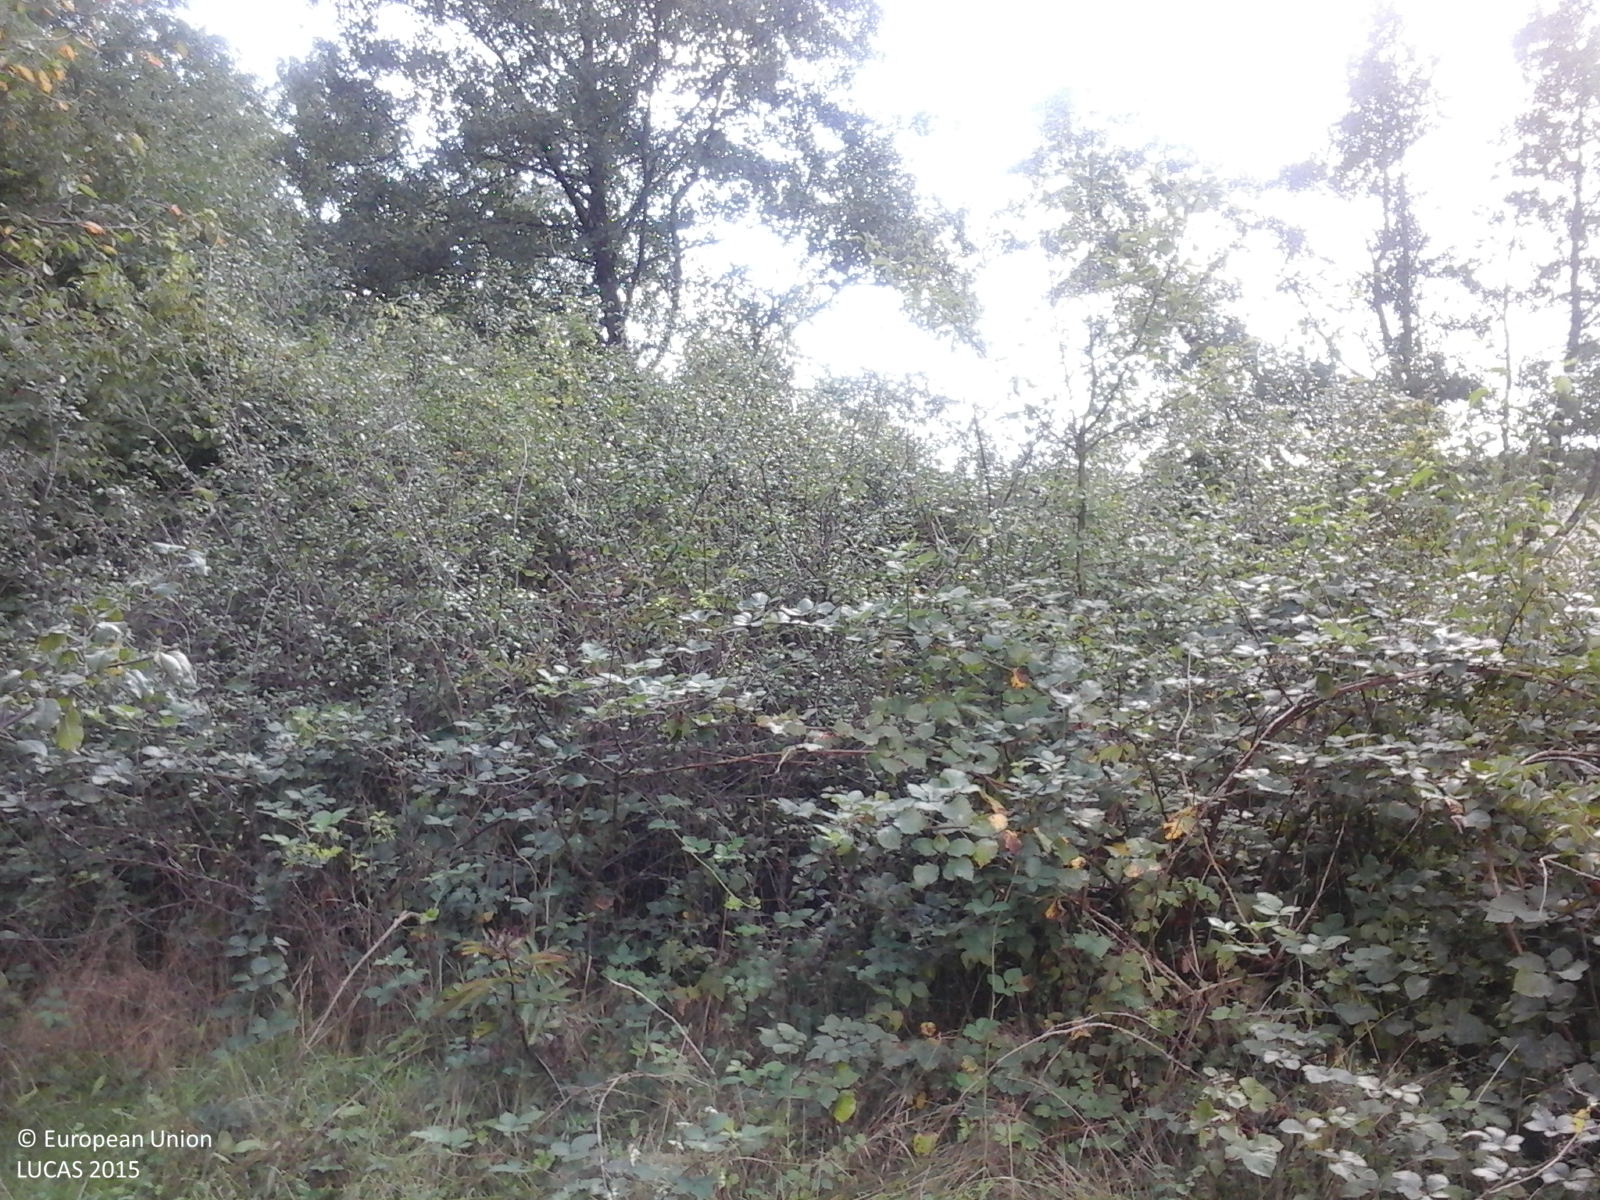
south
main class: Woodland
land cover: Broadleaved woodland
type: beech forest
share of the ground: > 75 %
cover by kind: broadleaved forest trees 100 %
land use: Forestry
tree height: > 5 m
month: September
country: RO
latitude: 45.1293
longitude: 23.4716
